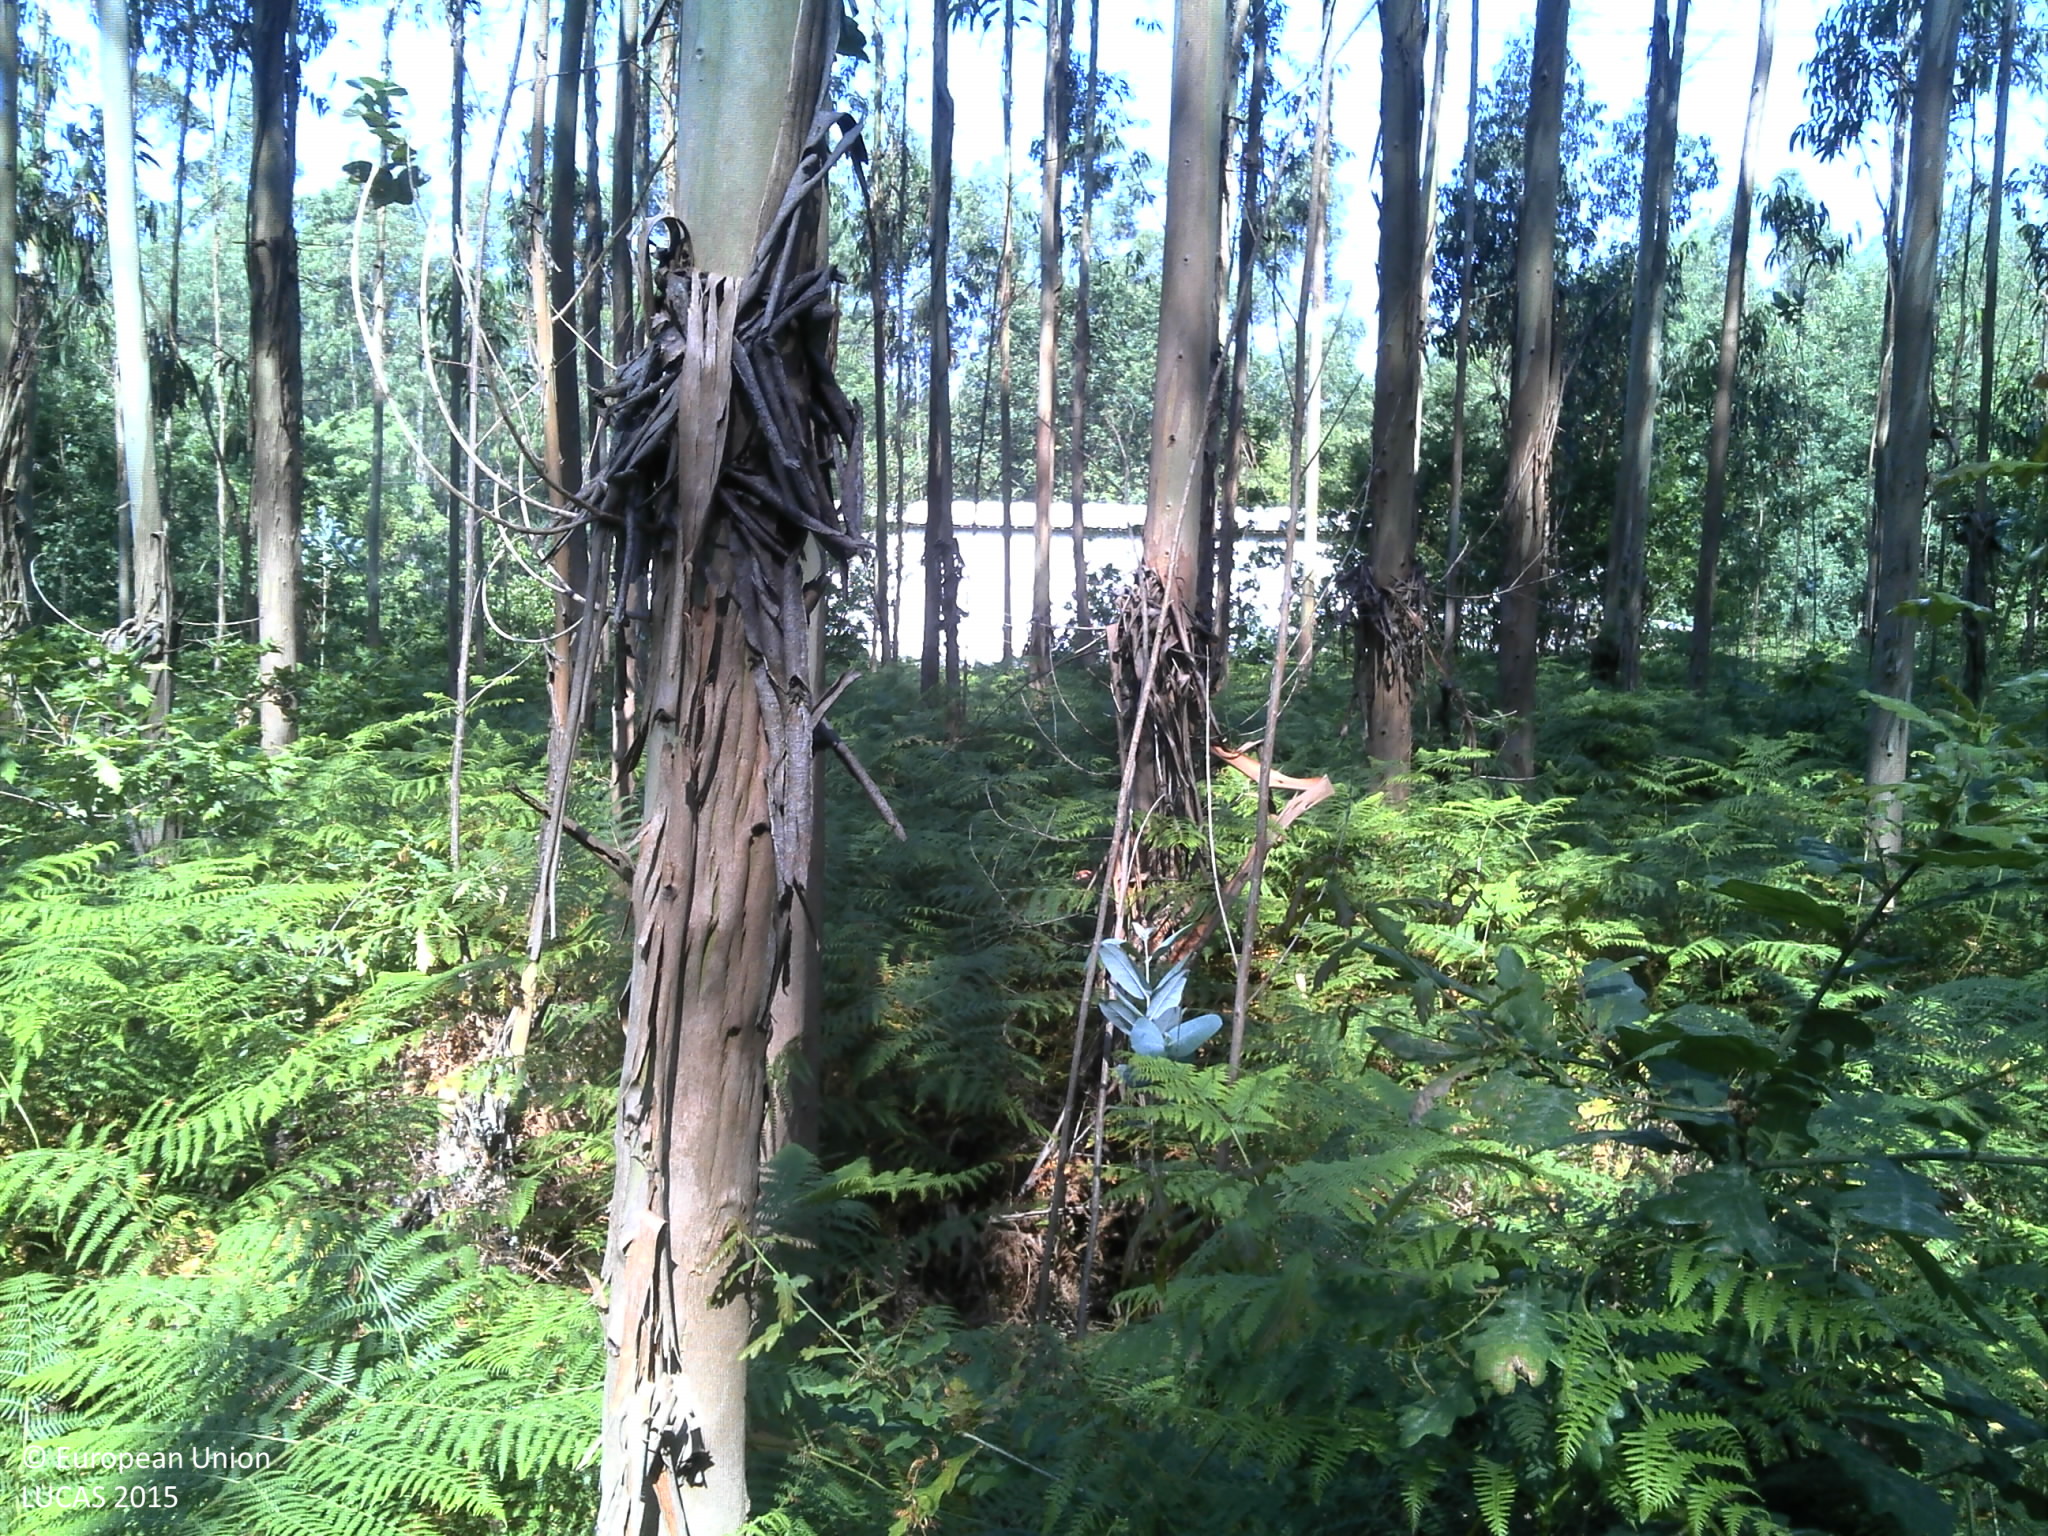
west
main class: Woodland
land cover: Broadleaved woodland
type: exotic forest
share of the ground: 50 - 75 %
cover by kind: broadleaved forest trees 70 %, shrubs 20 %, unconsolidated bare surface 10 %
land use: Forestry
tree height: > 5 m
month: June
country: PT
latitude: 40.8194
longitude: -8.5091
